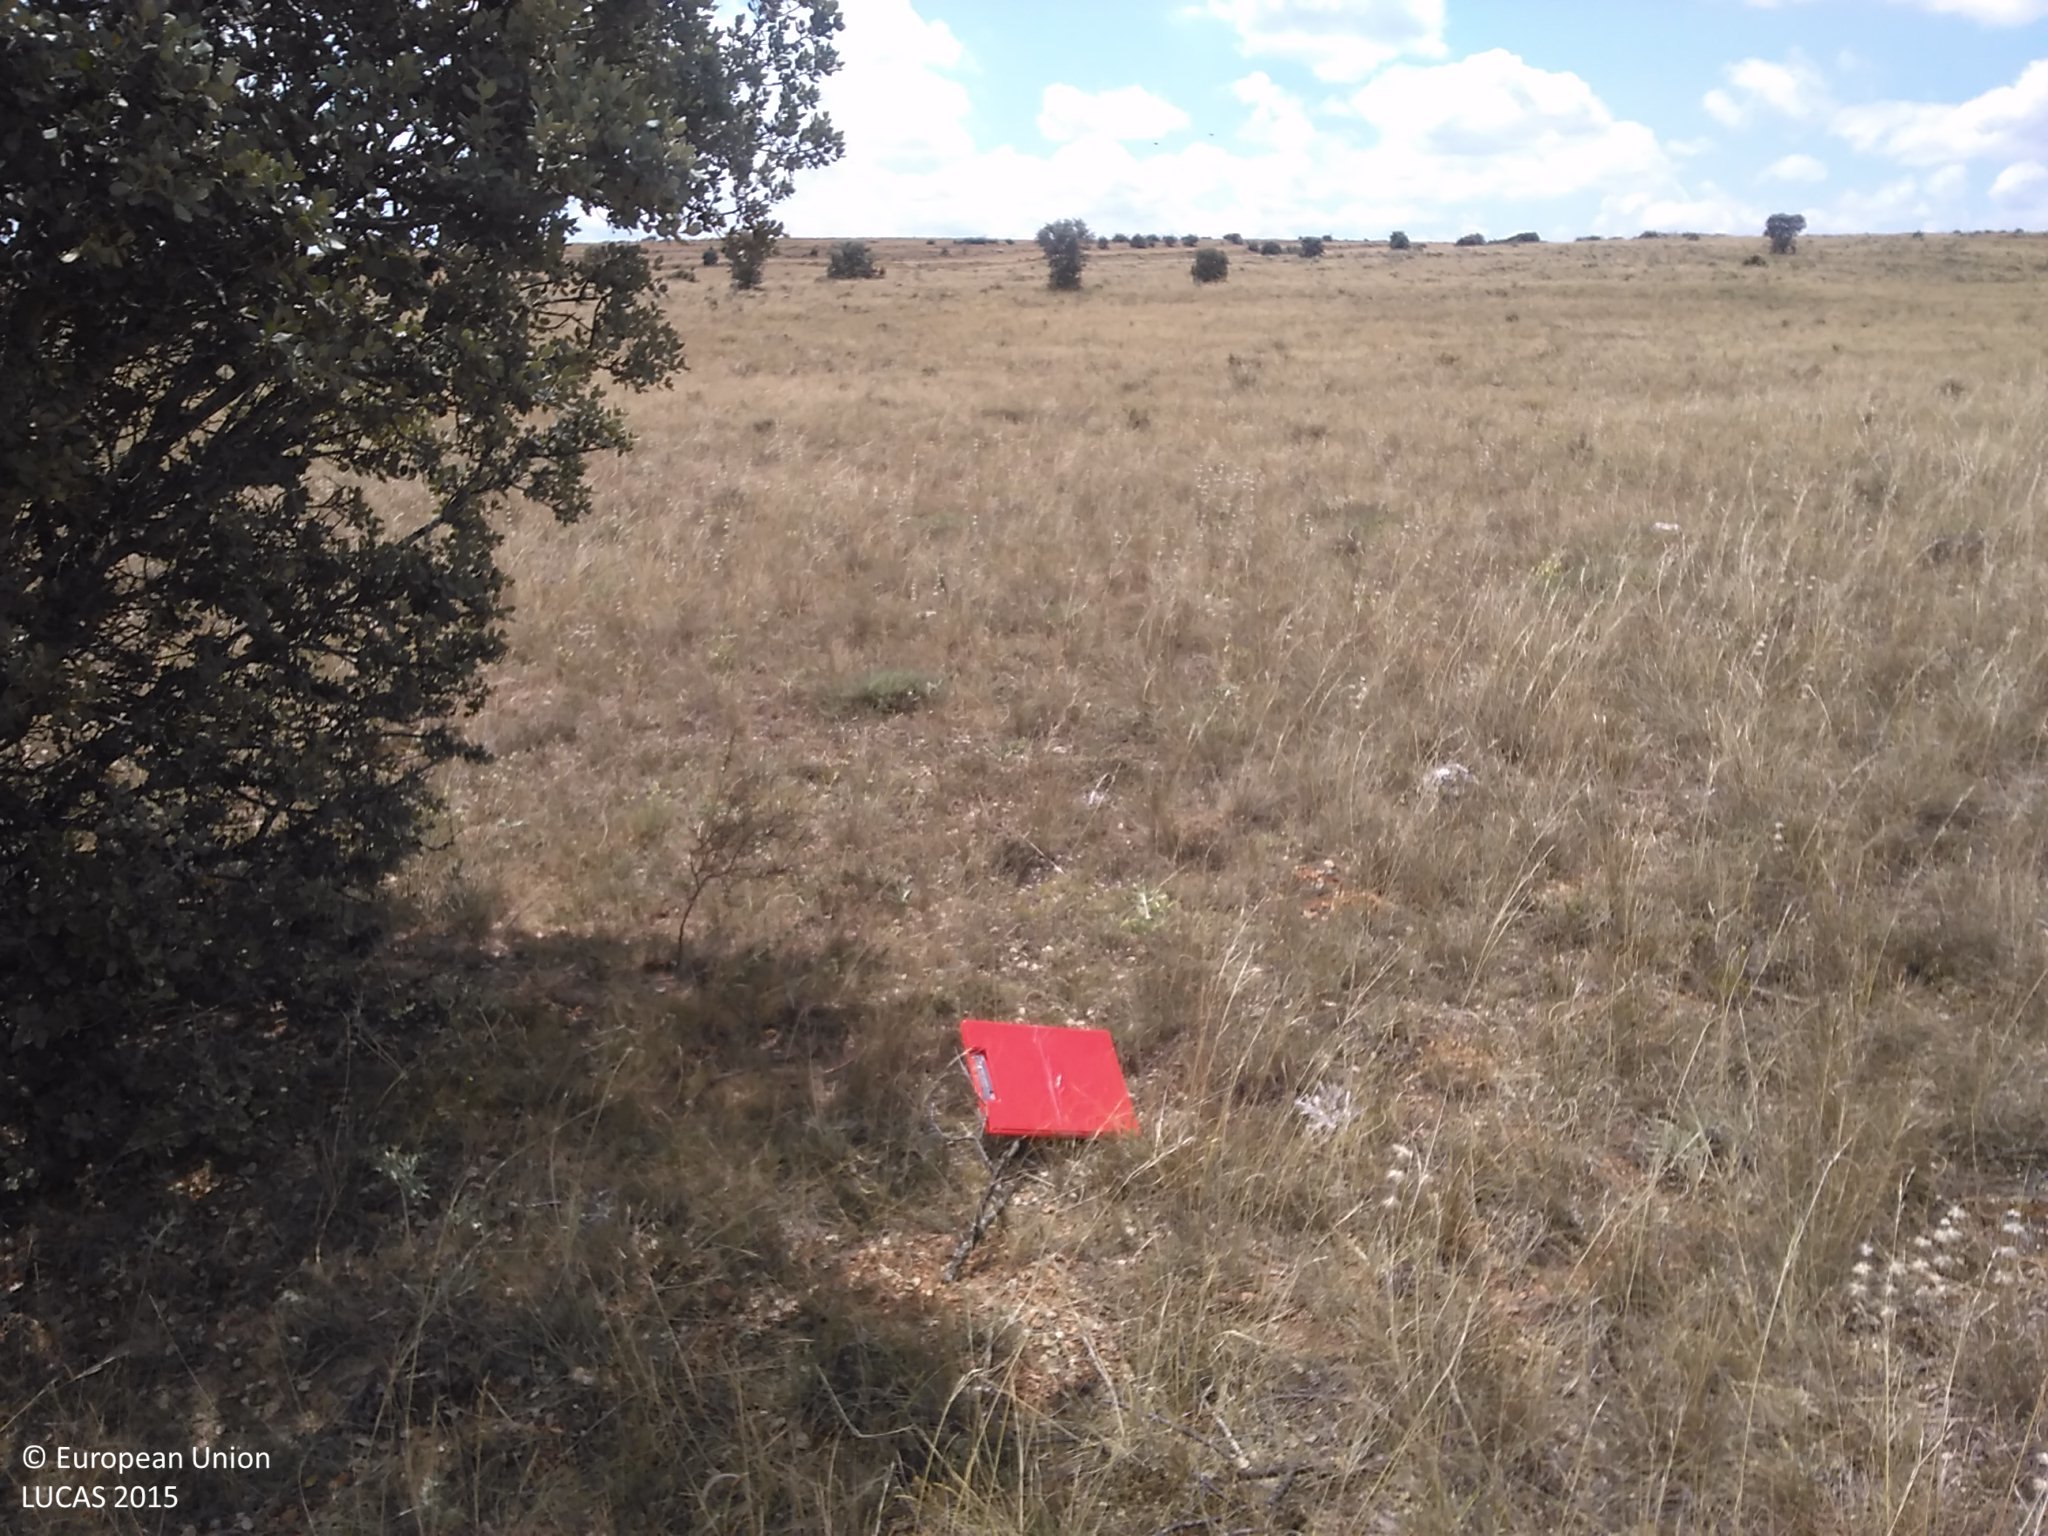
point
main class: Grassland
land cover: Grassland with sparse tree/shrub cover
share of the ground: 10 - 25 %
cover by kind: herbaceous plants 70 %, unconsolidated bare surface 20 %, broadleaved forest trees 5 %, shrubs 5 %
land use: Semi-natural and natural areas not in use
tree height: < 5 m
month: July
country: ES
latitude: 41.7741
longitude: -2.2950
